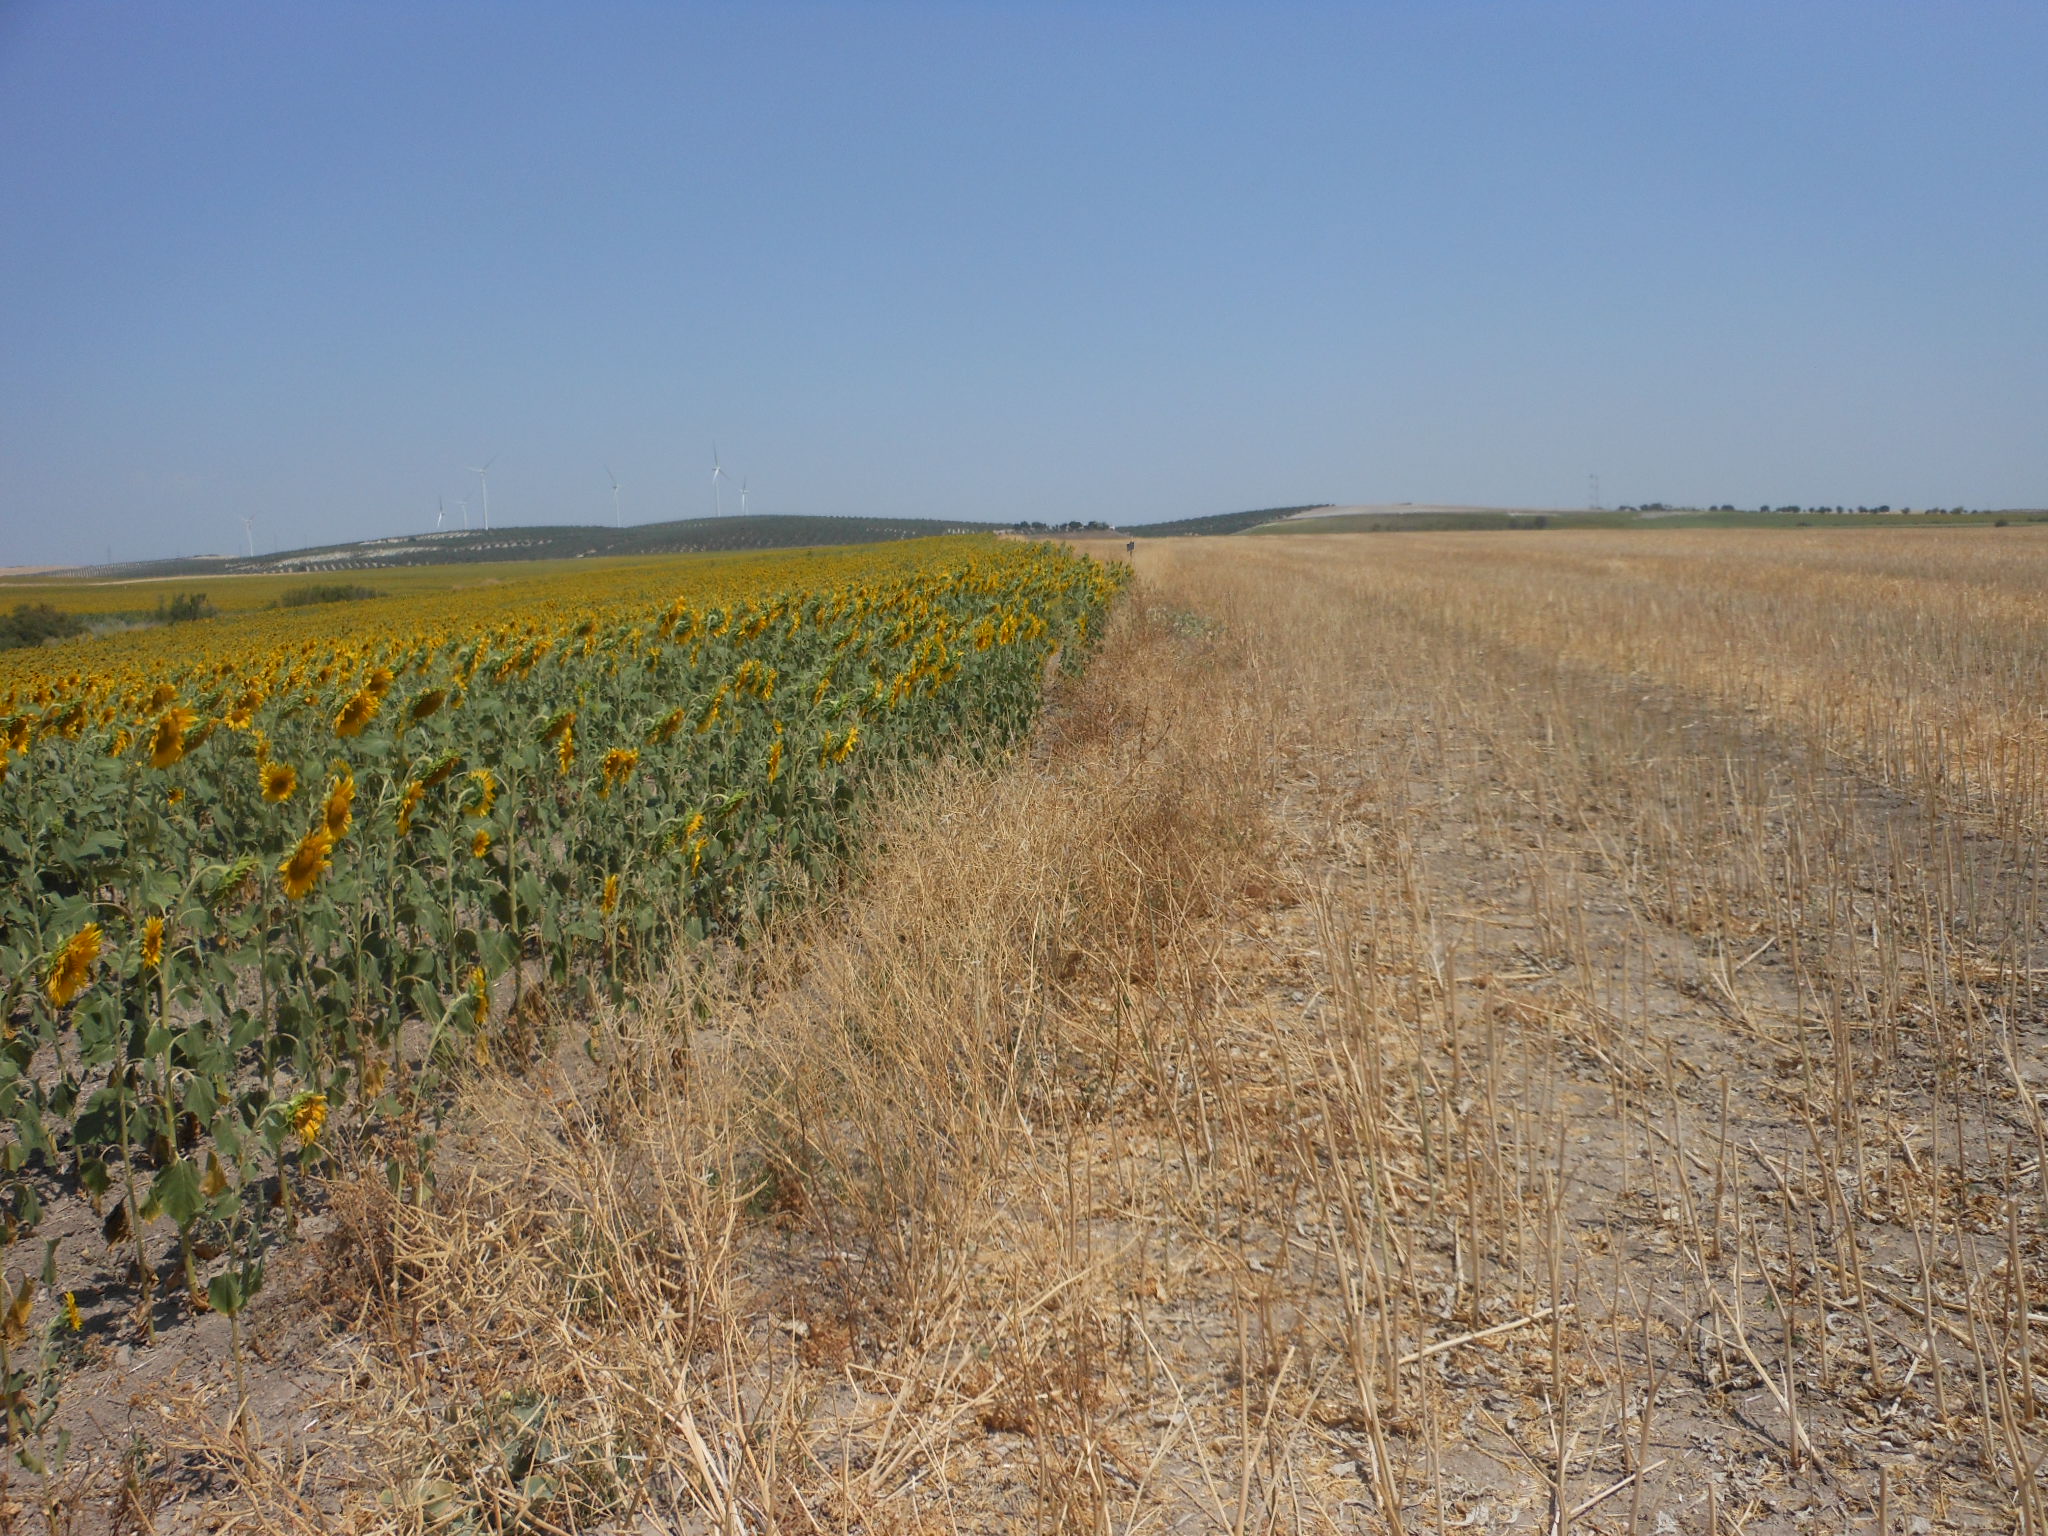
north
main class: Cropland
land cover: Sunflower
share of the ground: 50 - 75 %
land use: Agriculture (excluding fallow land and kitchen gardens)
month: June
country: ES
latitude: 37.4328
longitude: -5.1212
